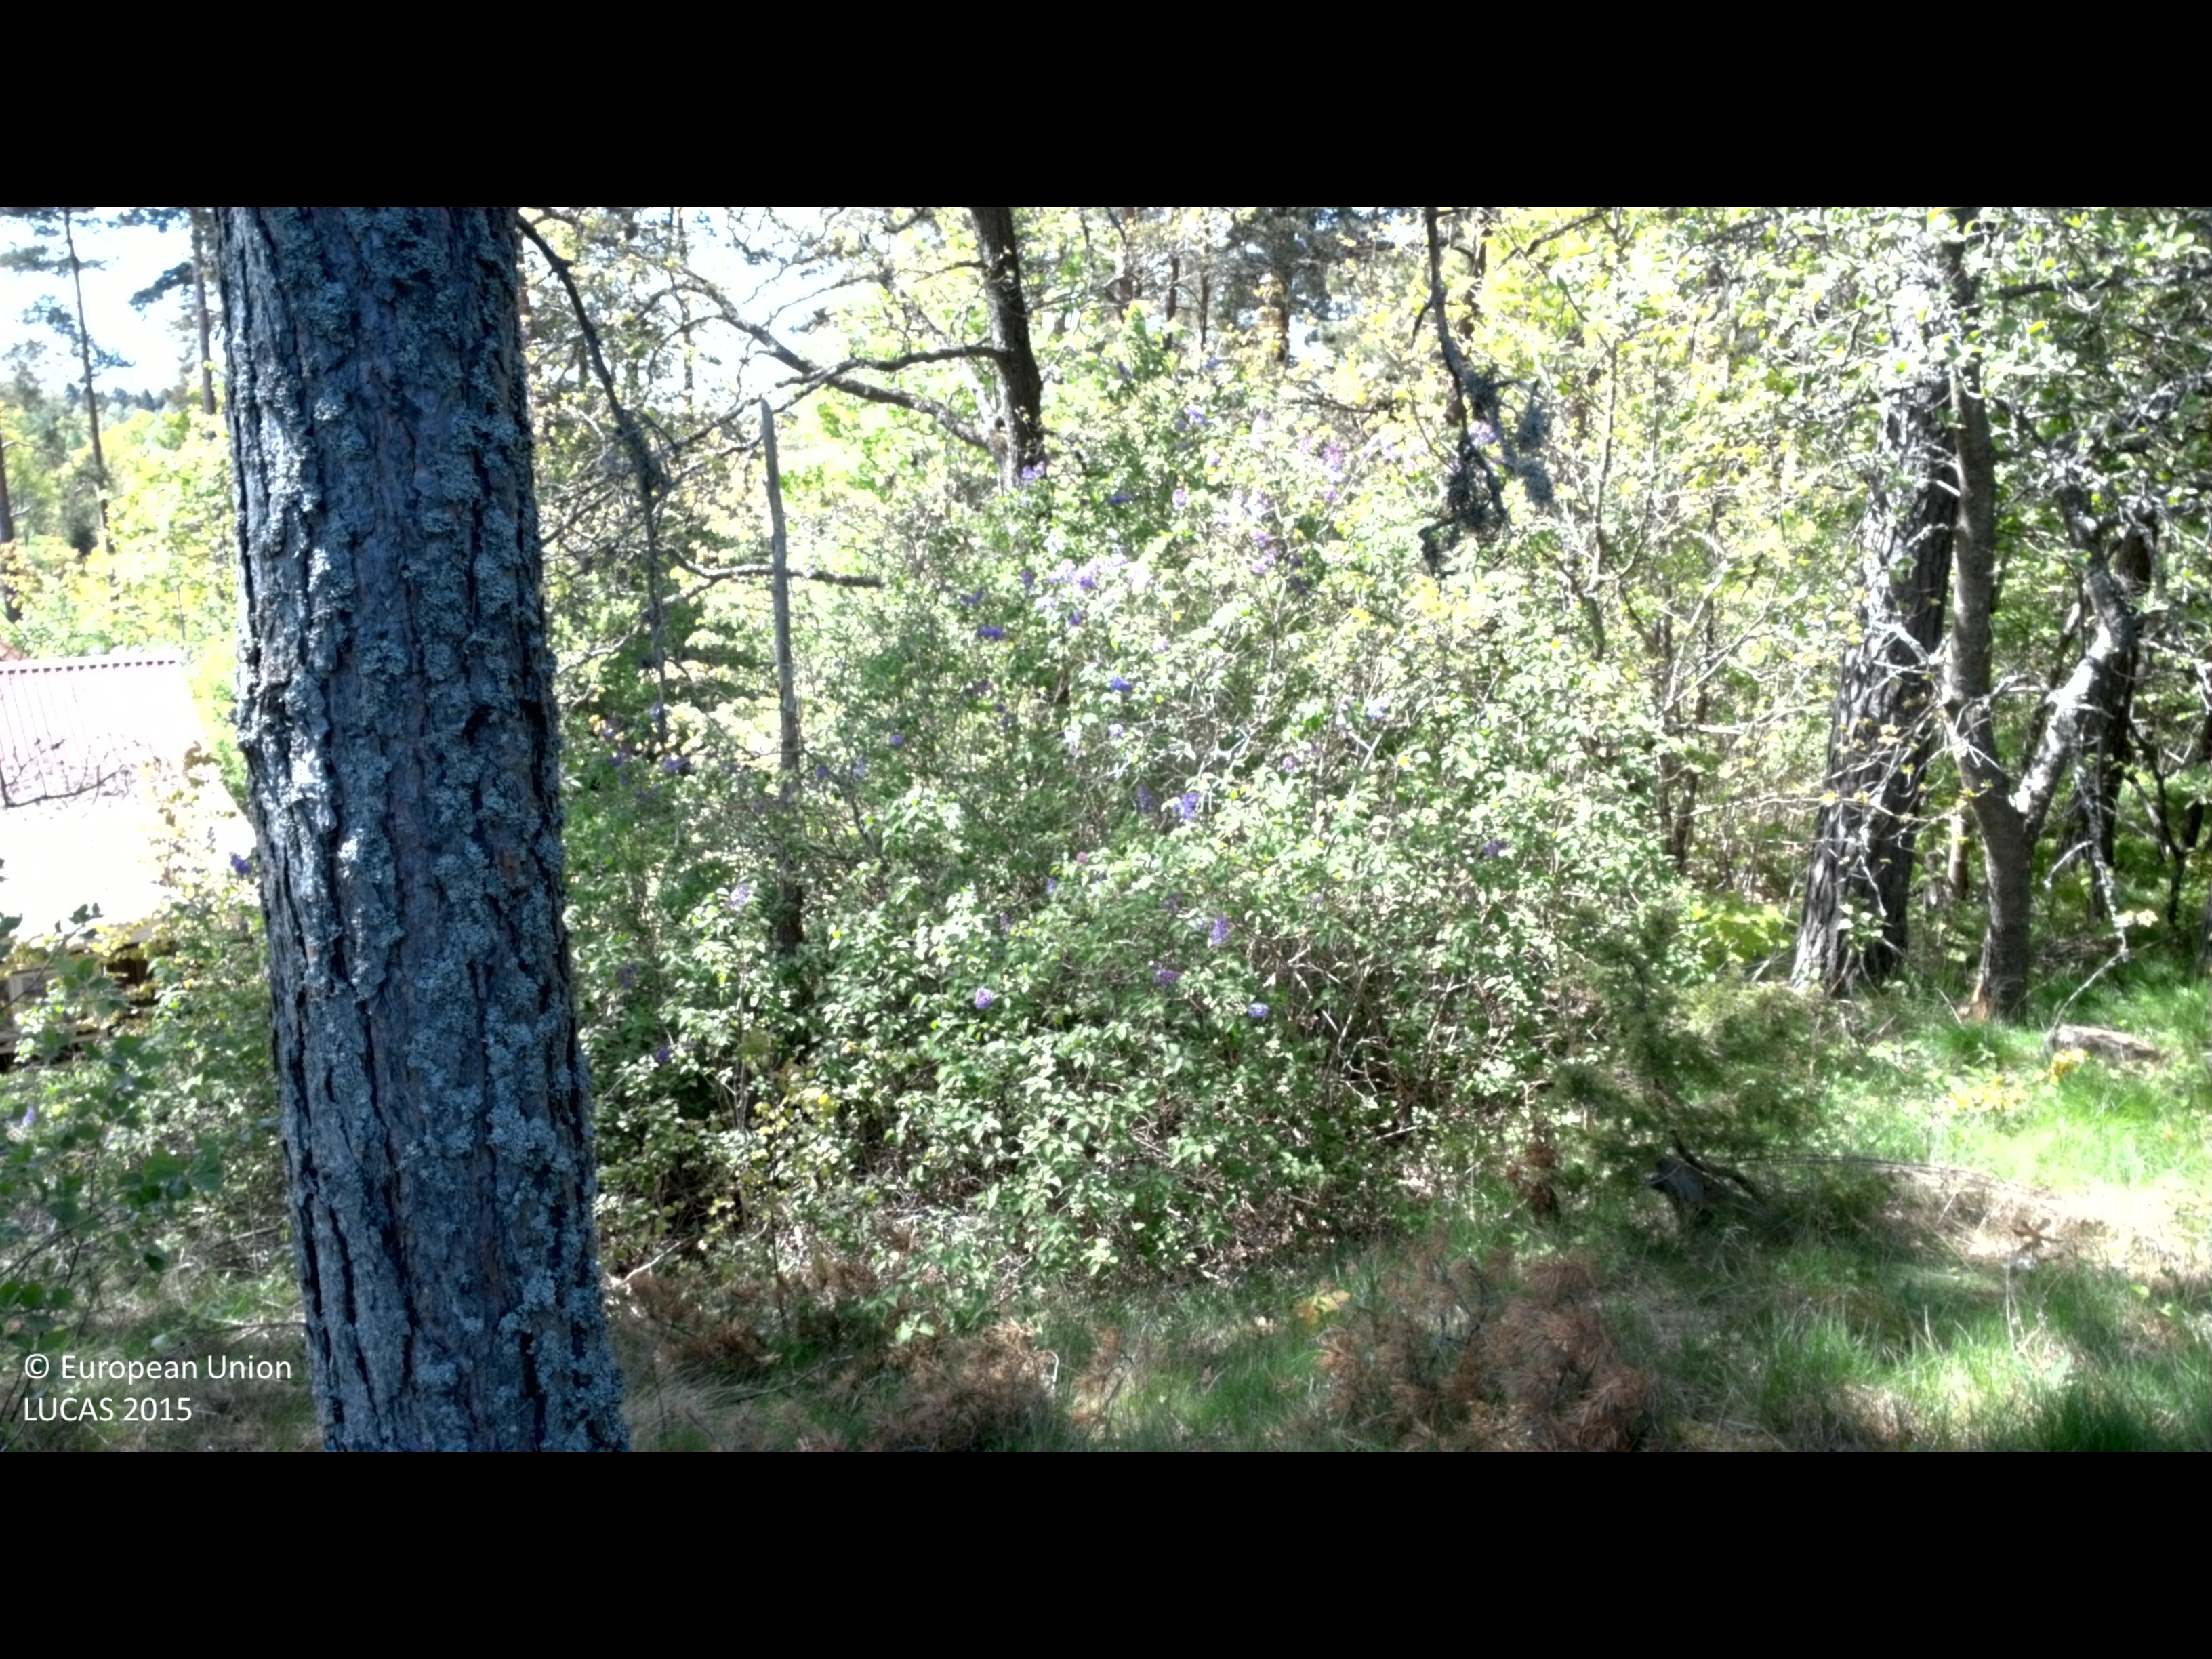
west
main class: Woodland
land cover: Pine dominated coniferous woodland
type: boreal forest
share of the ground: 25 - 50 %
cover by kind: coniferous forest trees 60 %, shrubs 15 %, herbaceous plants 15 %, broadleaved forest trees 10 %
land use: Forestry
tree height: > 5 m
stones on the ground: < 10 %
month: May
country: SE
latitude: 57.2964
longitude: 16.2886
